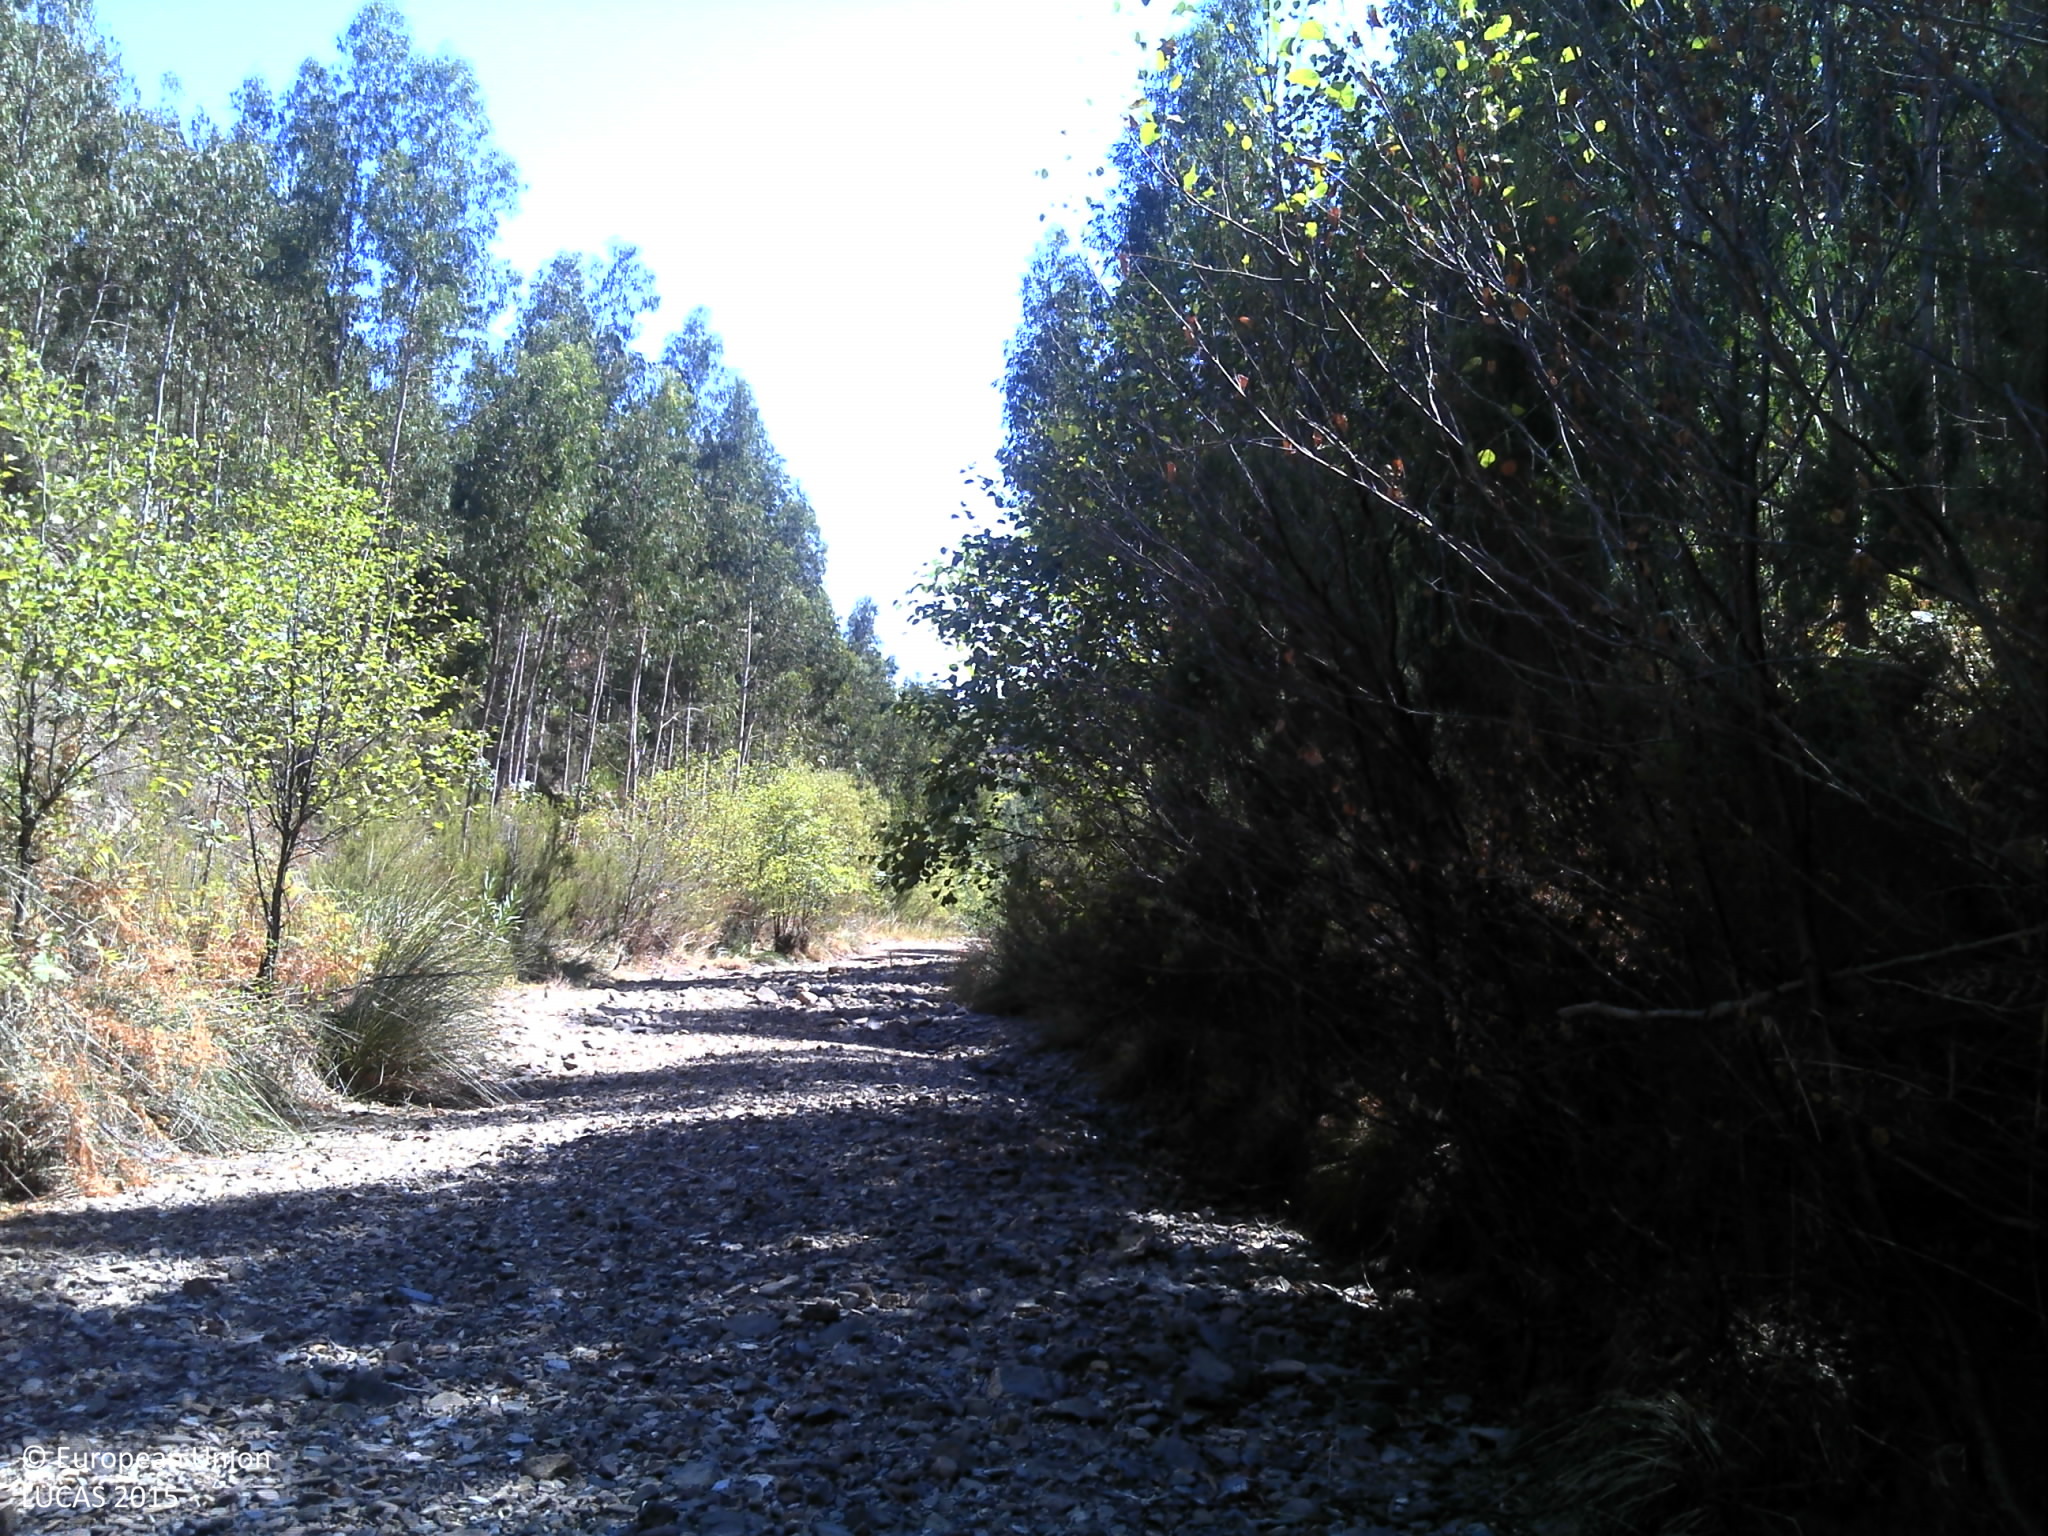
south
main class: Woodland
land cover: Broadleaved woodland
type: exotic forest
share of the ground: 50 - 75 %
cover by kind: broadleaved forest trees 70 %, unconsolidated bare surface 20 %, shrubs 10 %
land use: Forestry
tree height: > 5 m
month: September
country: PT
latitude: 37.3541
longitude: -8.4411
